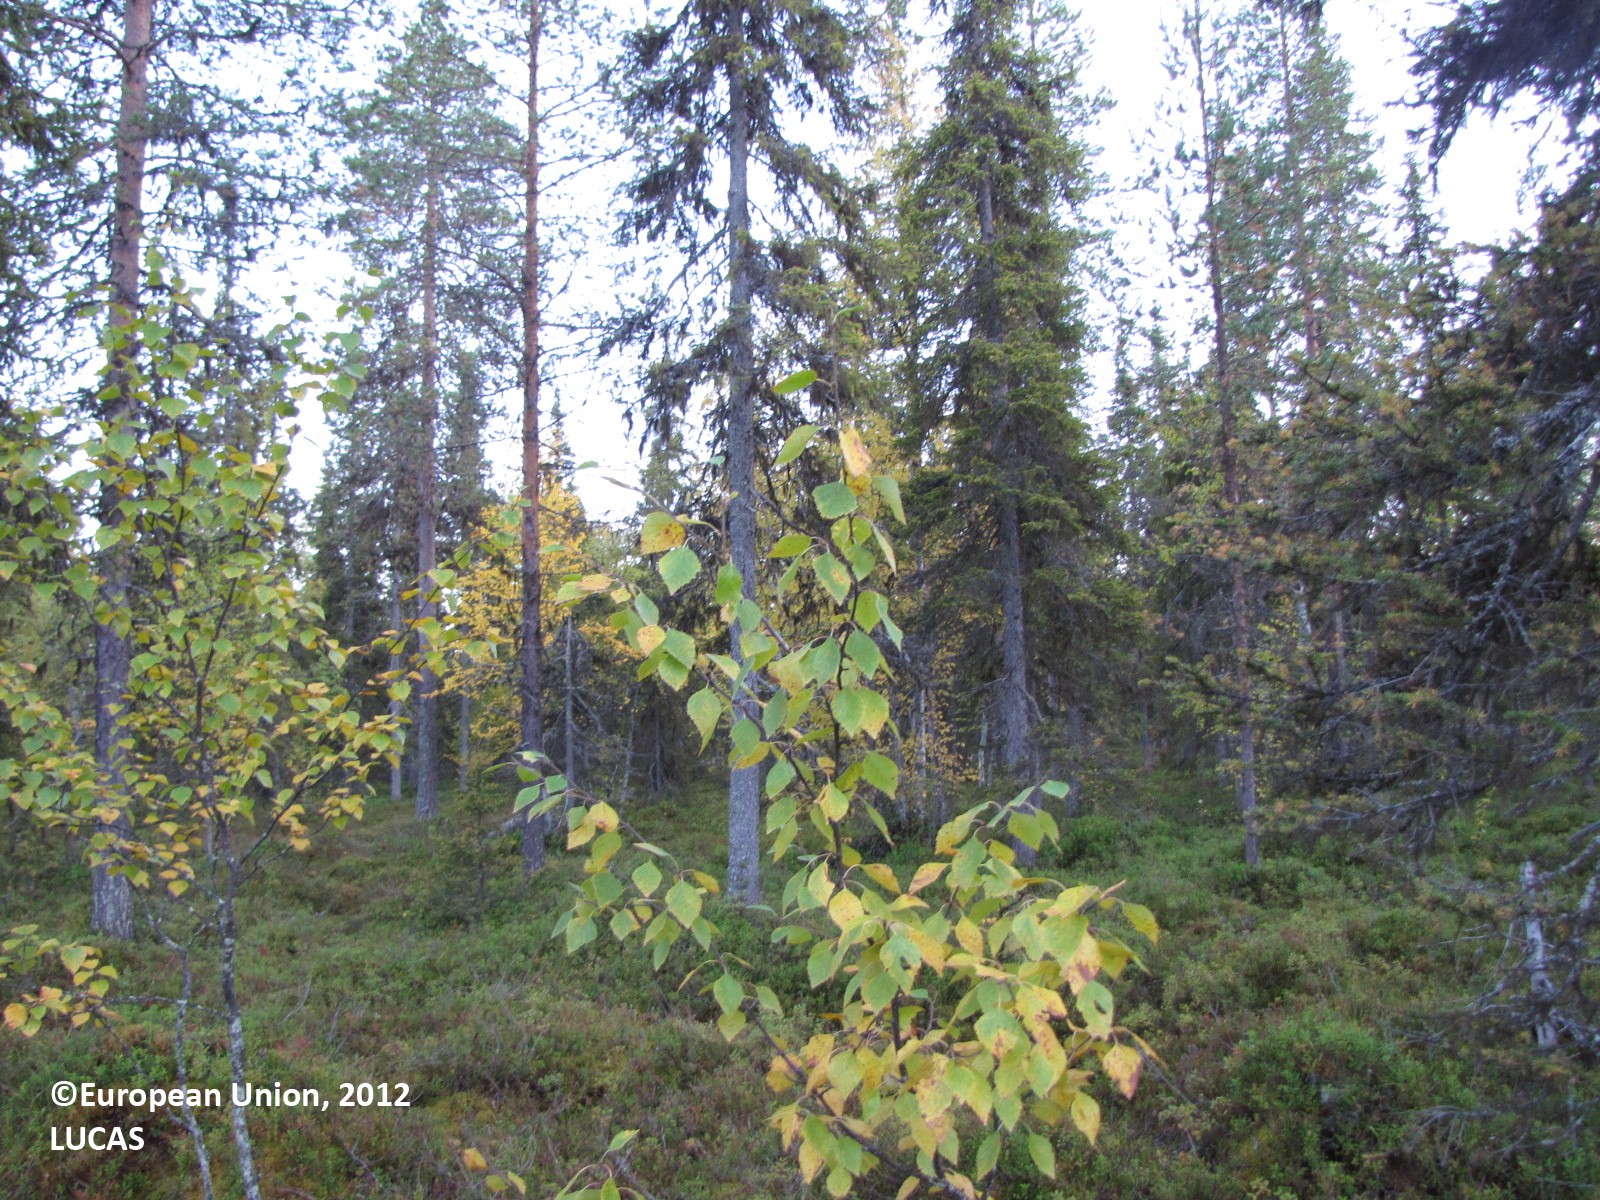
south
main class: Woodland
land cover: Spruce dominated coniferous woodland
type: boreal forest
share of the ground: 25 - 50 %
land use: Forestry
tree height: > 5 m
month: September
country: FI
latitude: 67.3665
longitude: 25.3467
